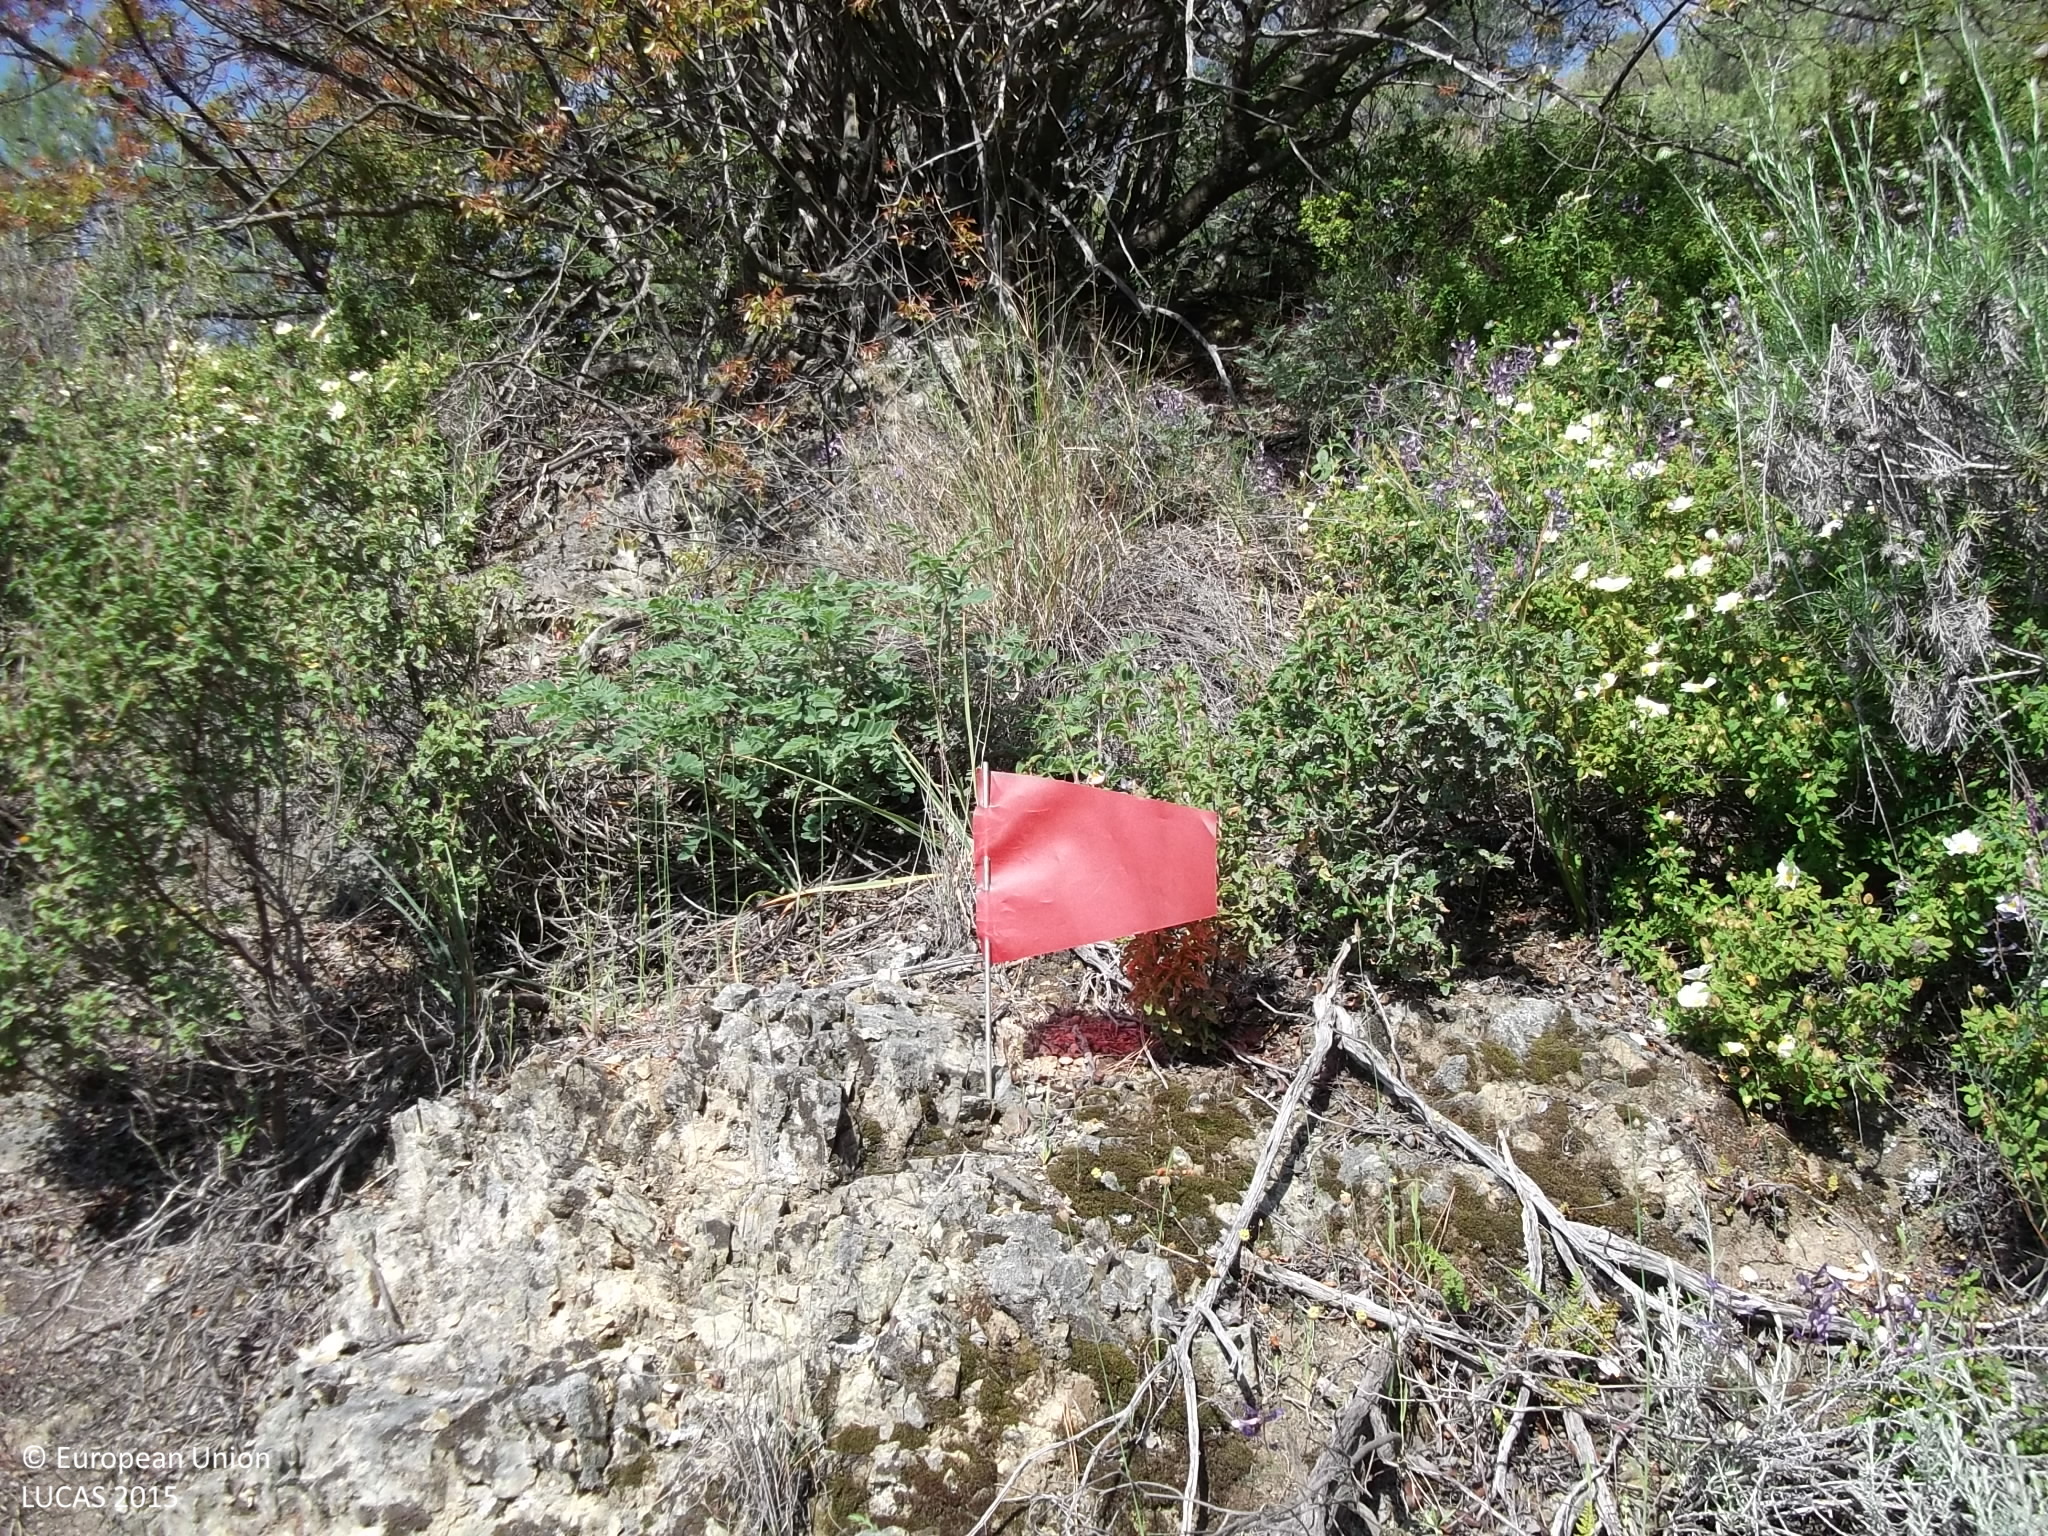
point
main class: Woodland
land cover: Pine dominated coniferous woodland
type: coniferous forest of the mediterranean region
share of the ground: 25 - 50 %
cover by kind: shrubs 50 %, coniferous forest trees 30 %, consolidated bare surface 10 %, unconsolidated bare surface 10 %
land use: Semi-natural and natural areas not in use
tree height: > 5 m
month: April
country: CY
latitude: 34.8821
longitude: 33.0952
